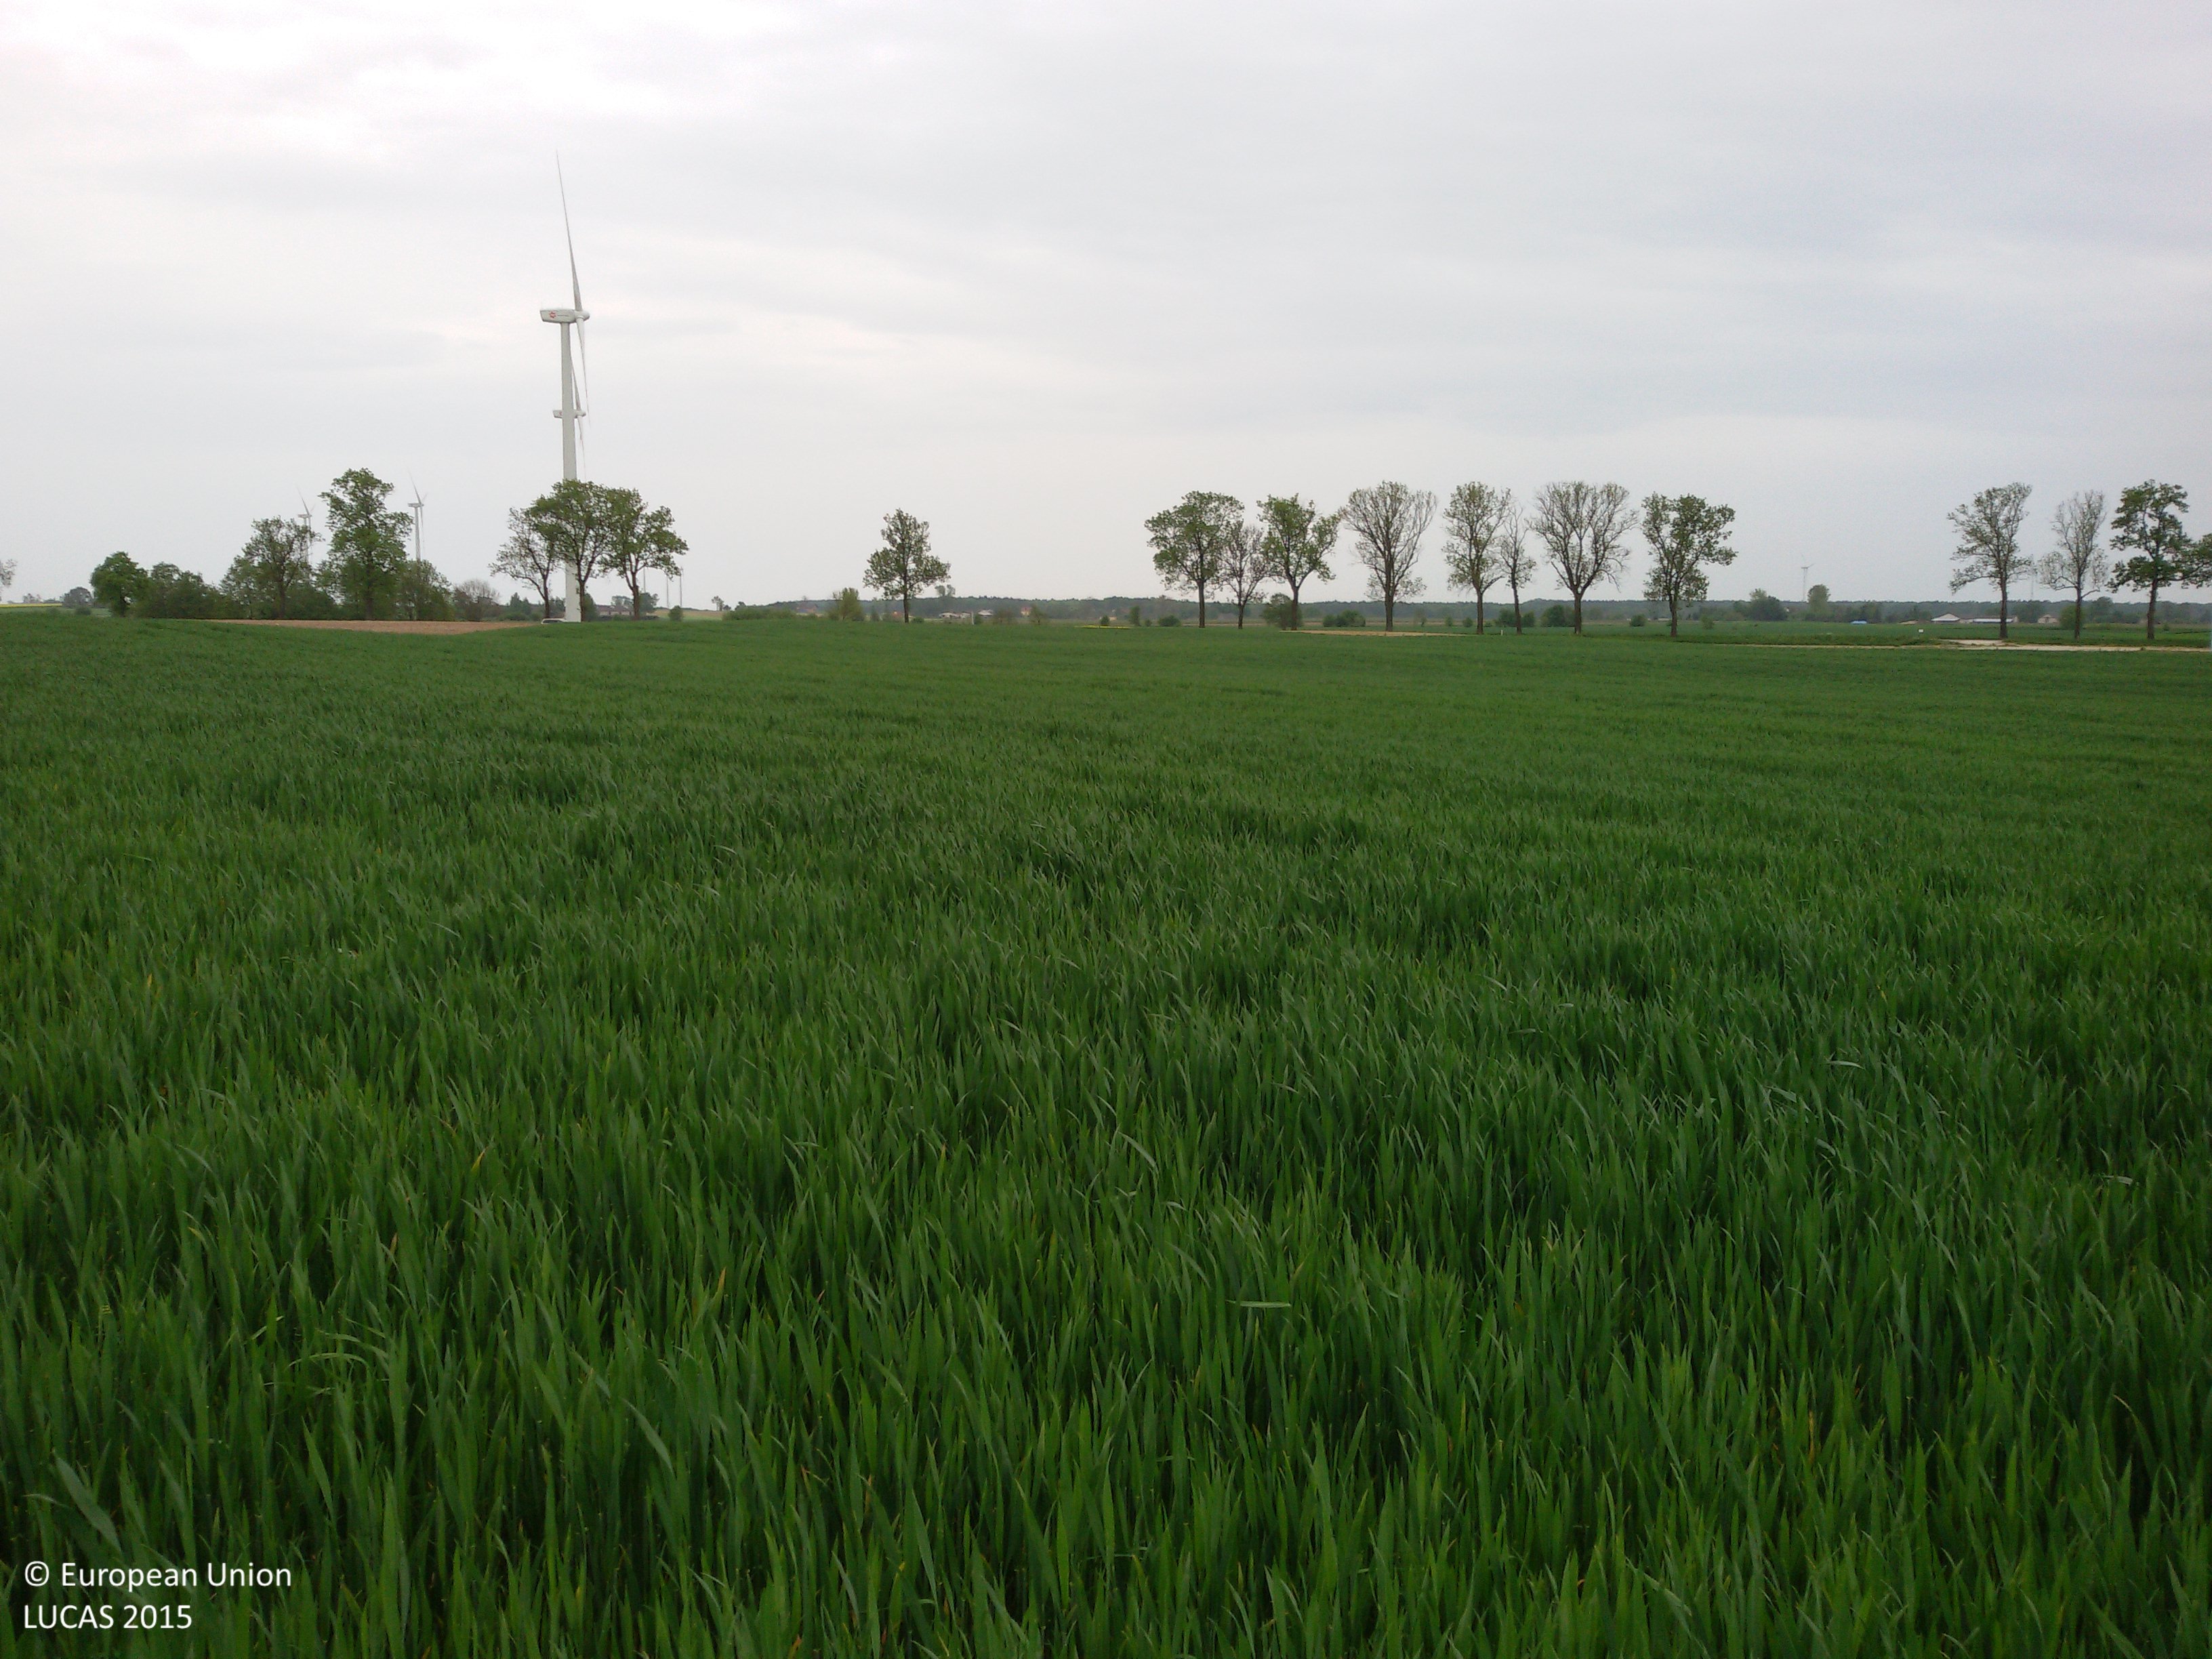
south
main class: Cropland
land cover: Common wheat
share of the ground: > 75 %
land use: Agriculture (excluding fallow land and kitchen gardens)
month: May
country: PL
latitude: 52.9708
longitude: 17.2026
